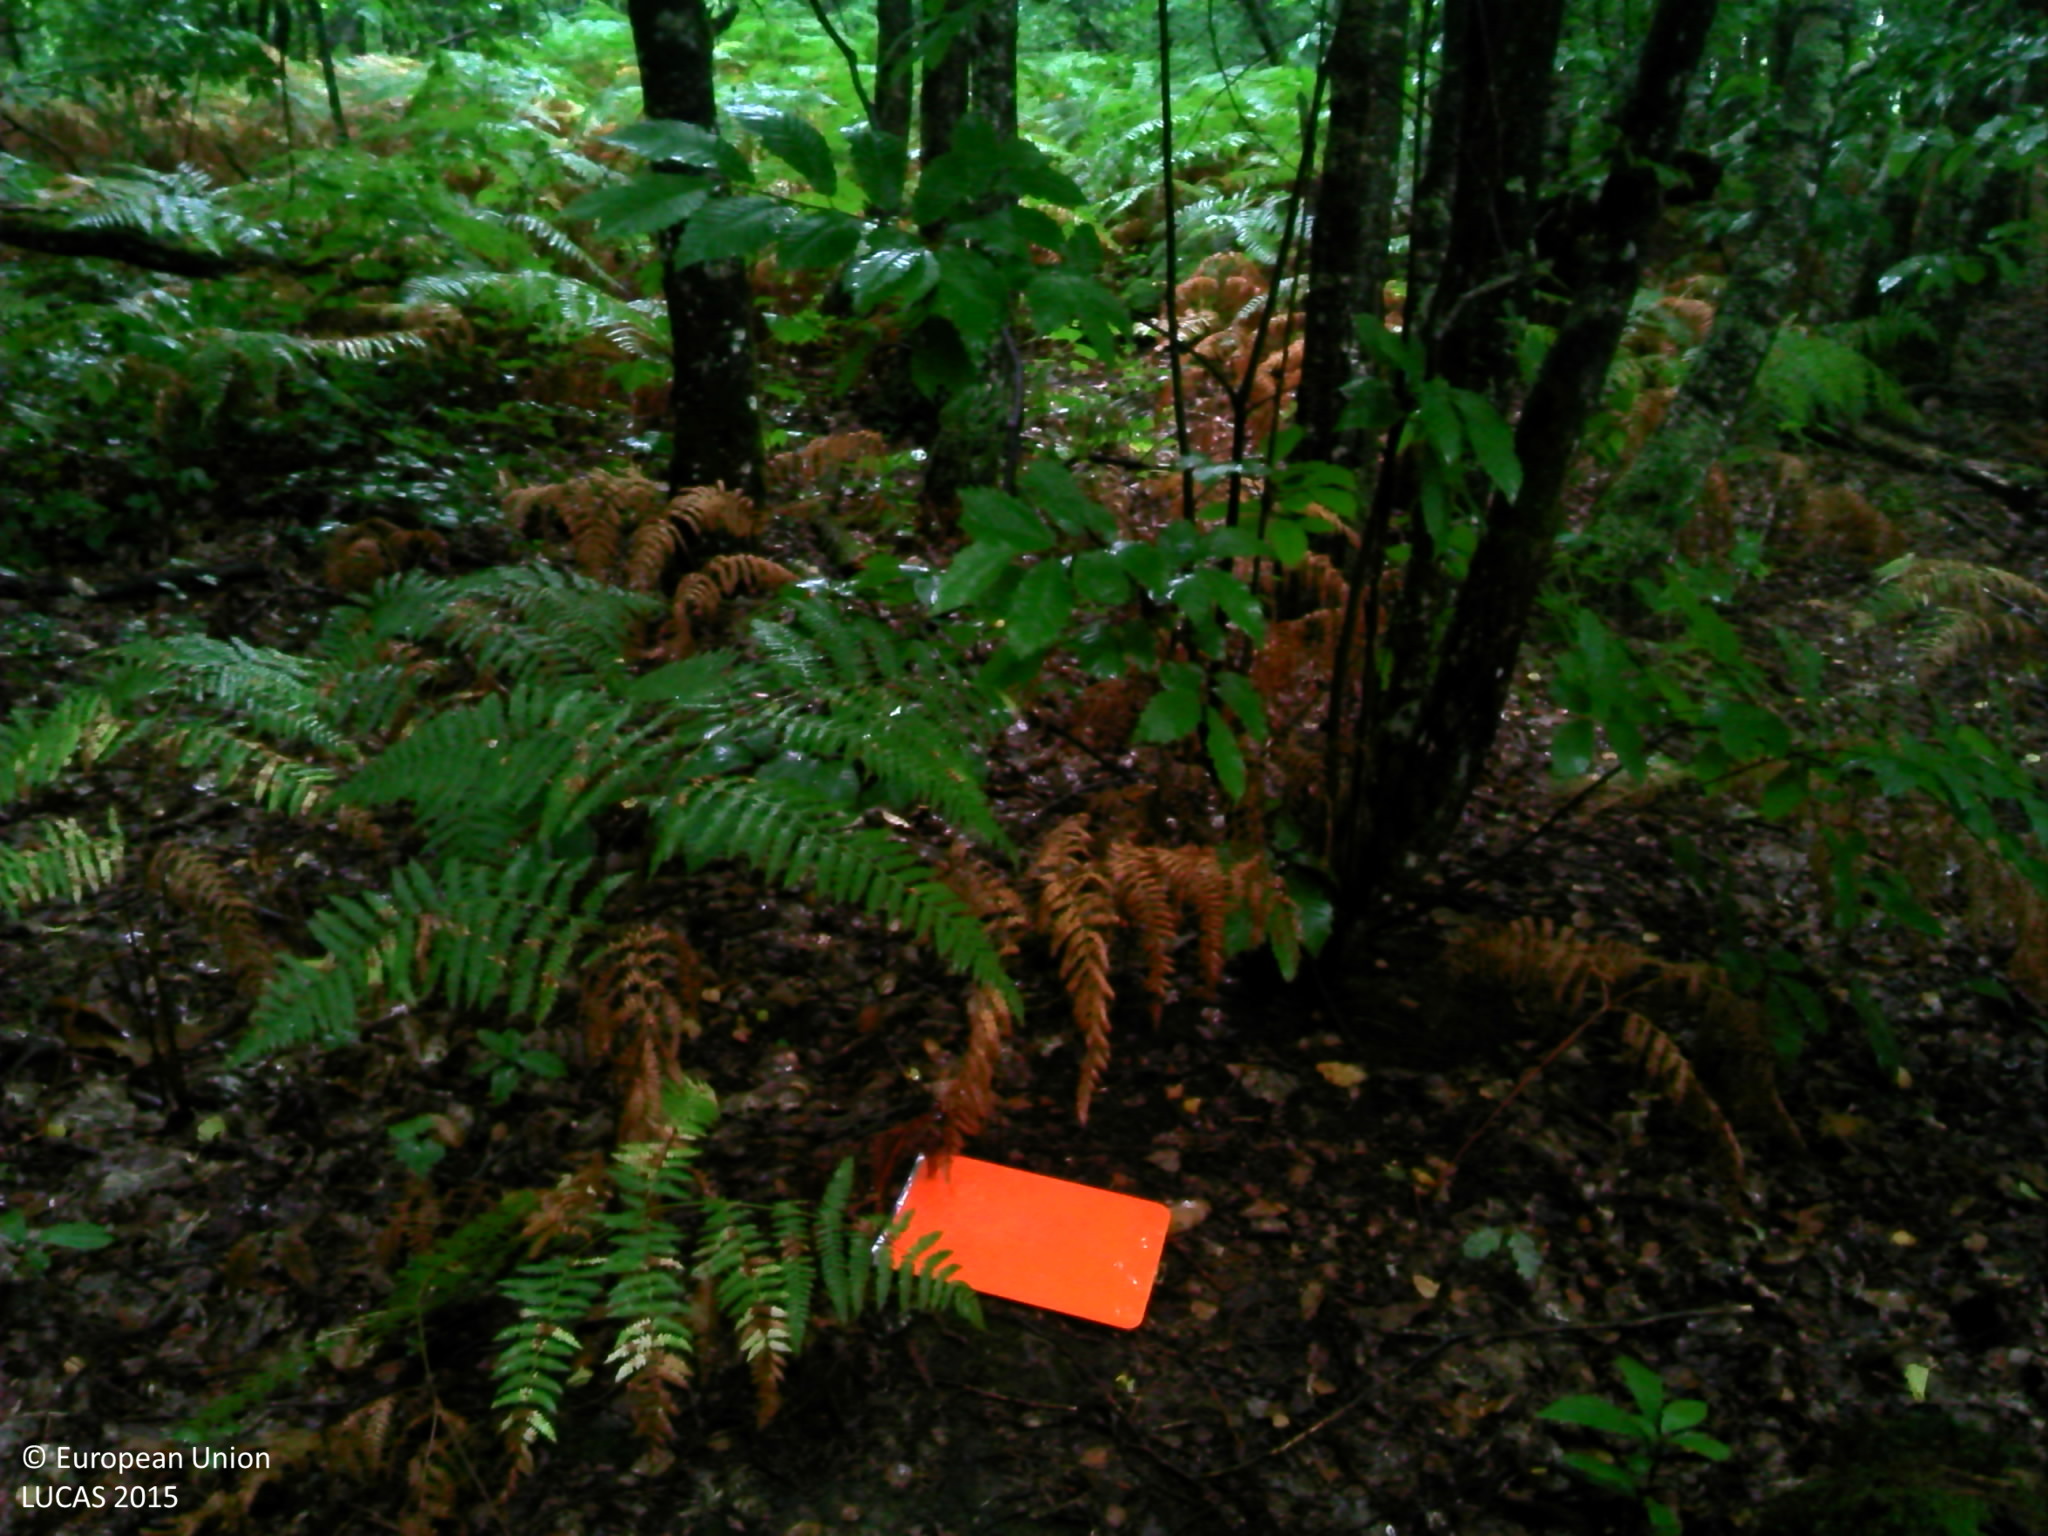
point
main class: Woodland
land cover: Broadleaved woodland
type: thermophilous deciduous forest
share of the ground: > 75 %
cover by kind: broadleaved forest trees 75 %, herbaceous plants 10 %, shrubs 5 %, lichens and mosses 5 %, consolidated bare surface 5 %
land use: Forestry
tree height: > 5 m
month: August
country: FR
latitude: 45.4684
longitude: 0.6383
